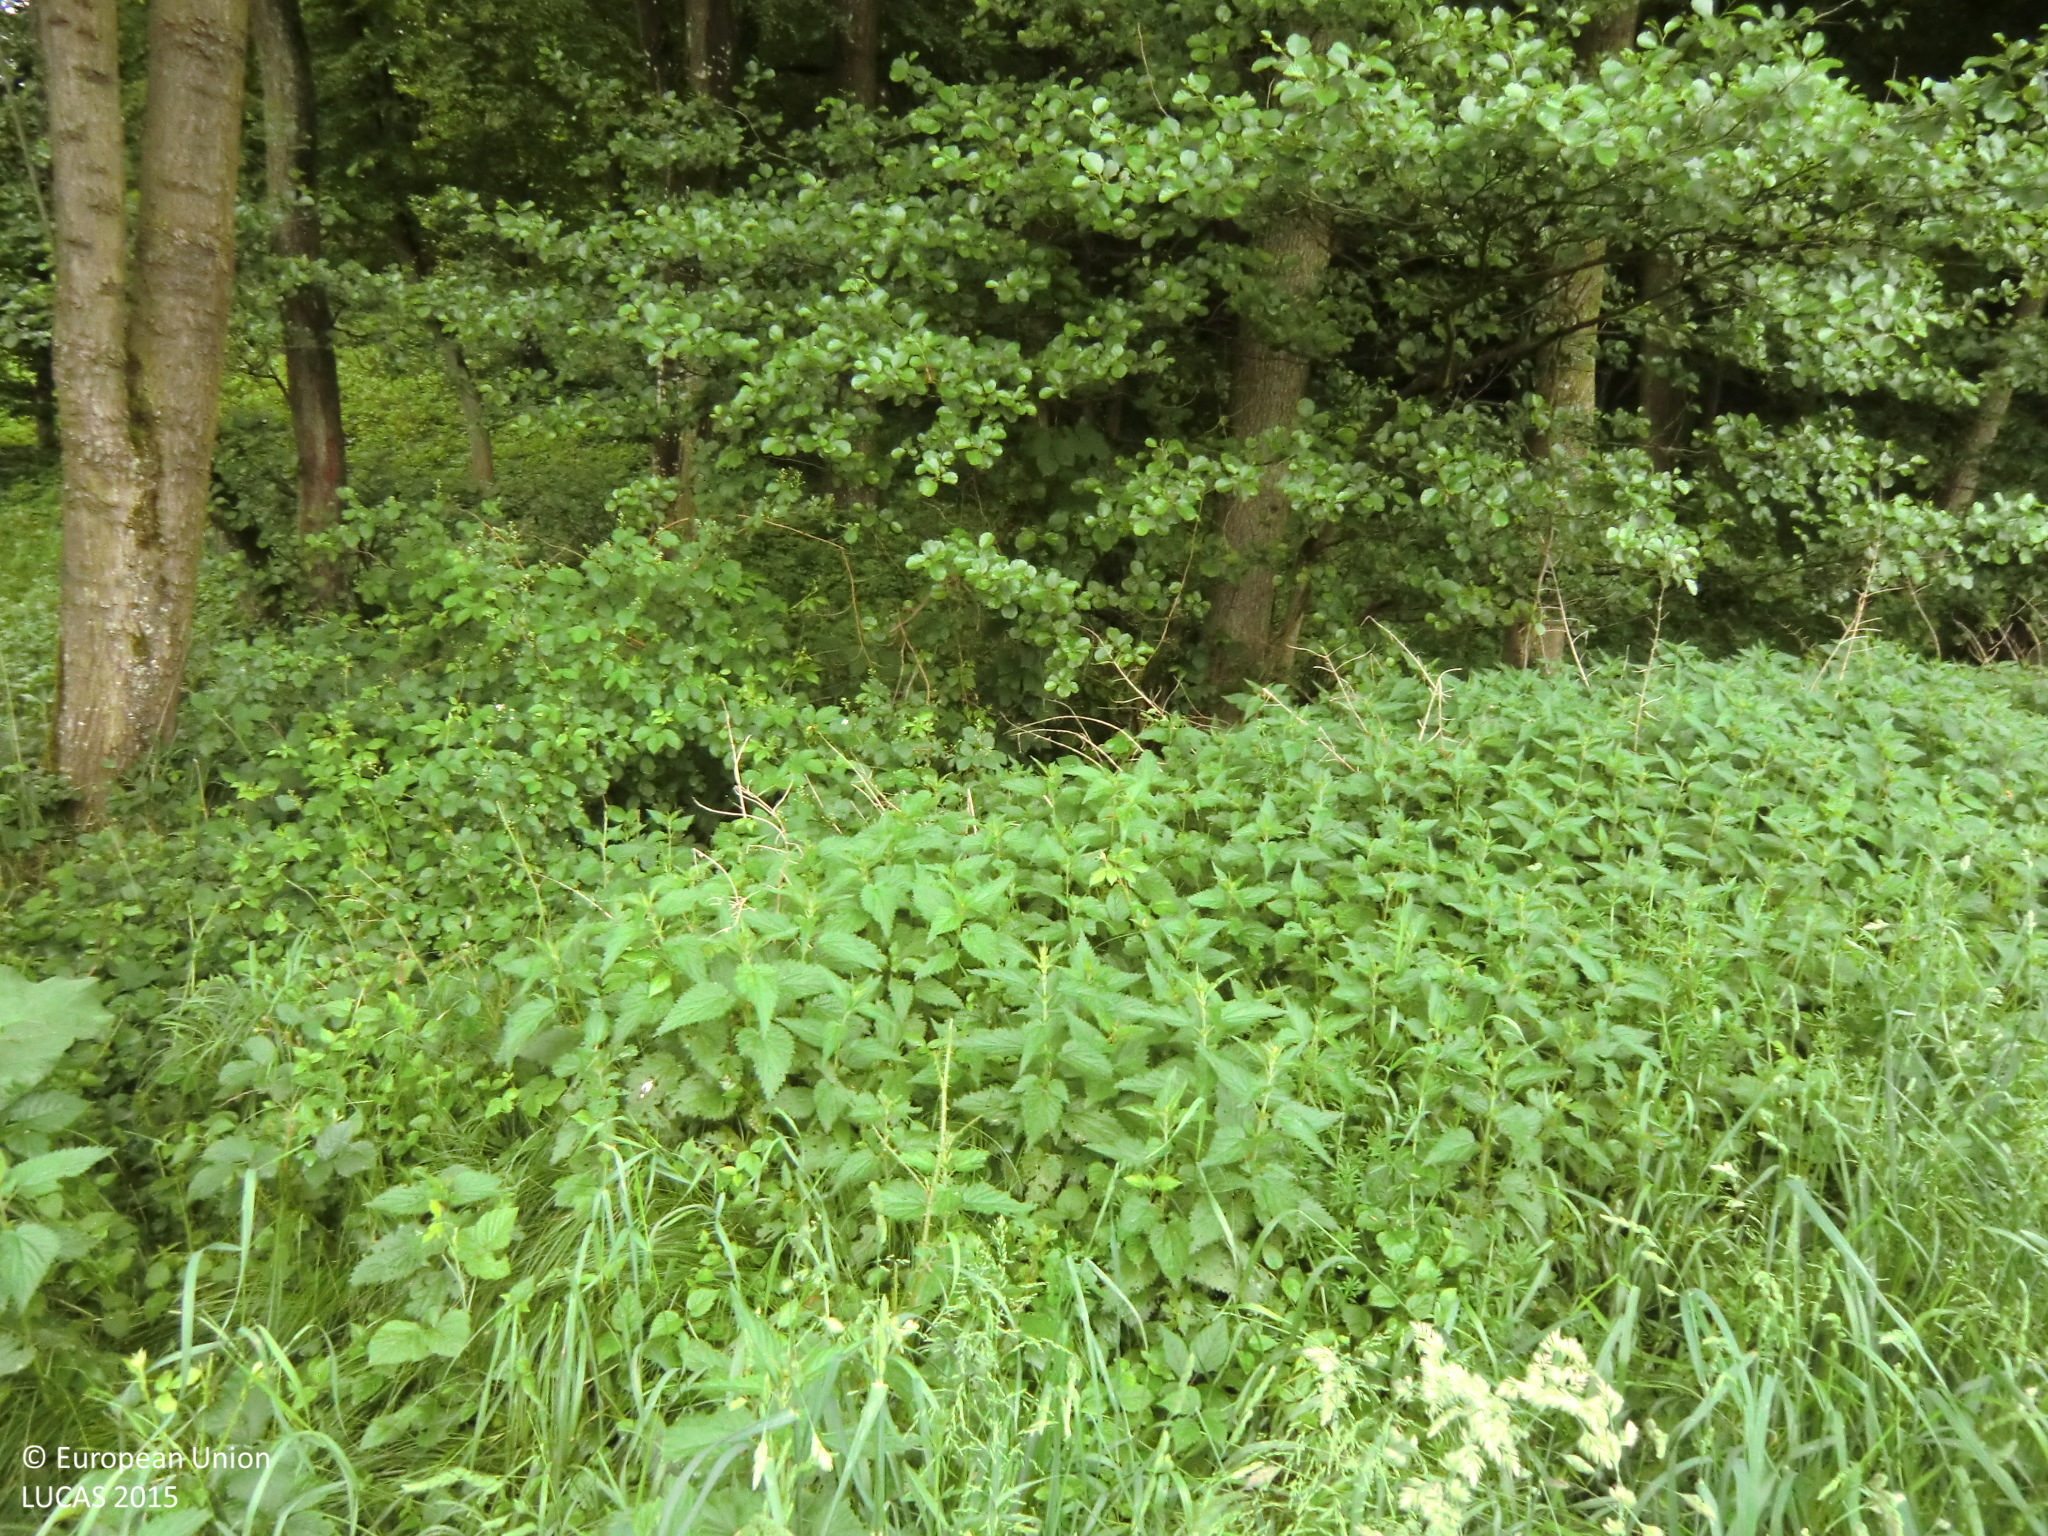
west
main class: Grassland
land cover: Grassland without tree/shrub cover
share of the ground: > 75 %
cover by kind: herbaceous plants 100 %
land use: Agriculture (excluding fallow land and kitchen gardens)
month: May
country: AT
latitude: 48.1637
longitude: 15.3934
